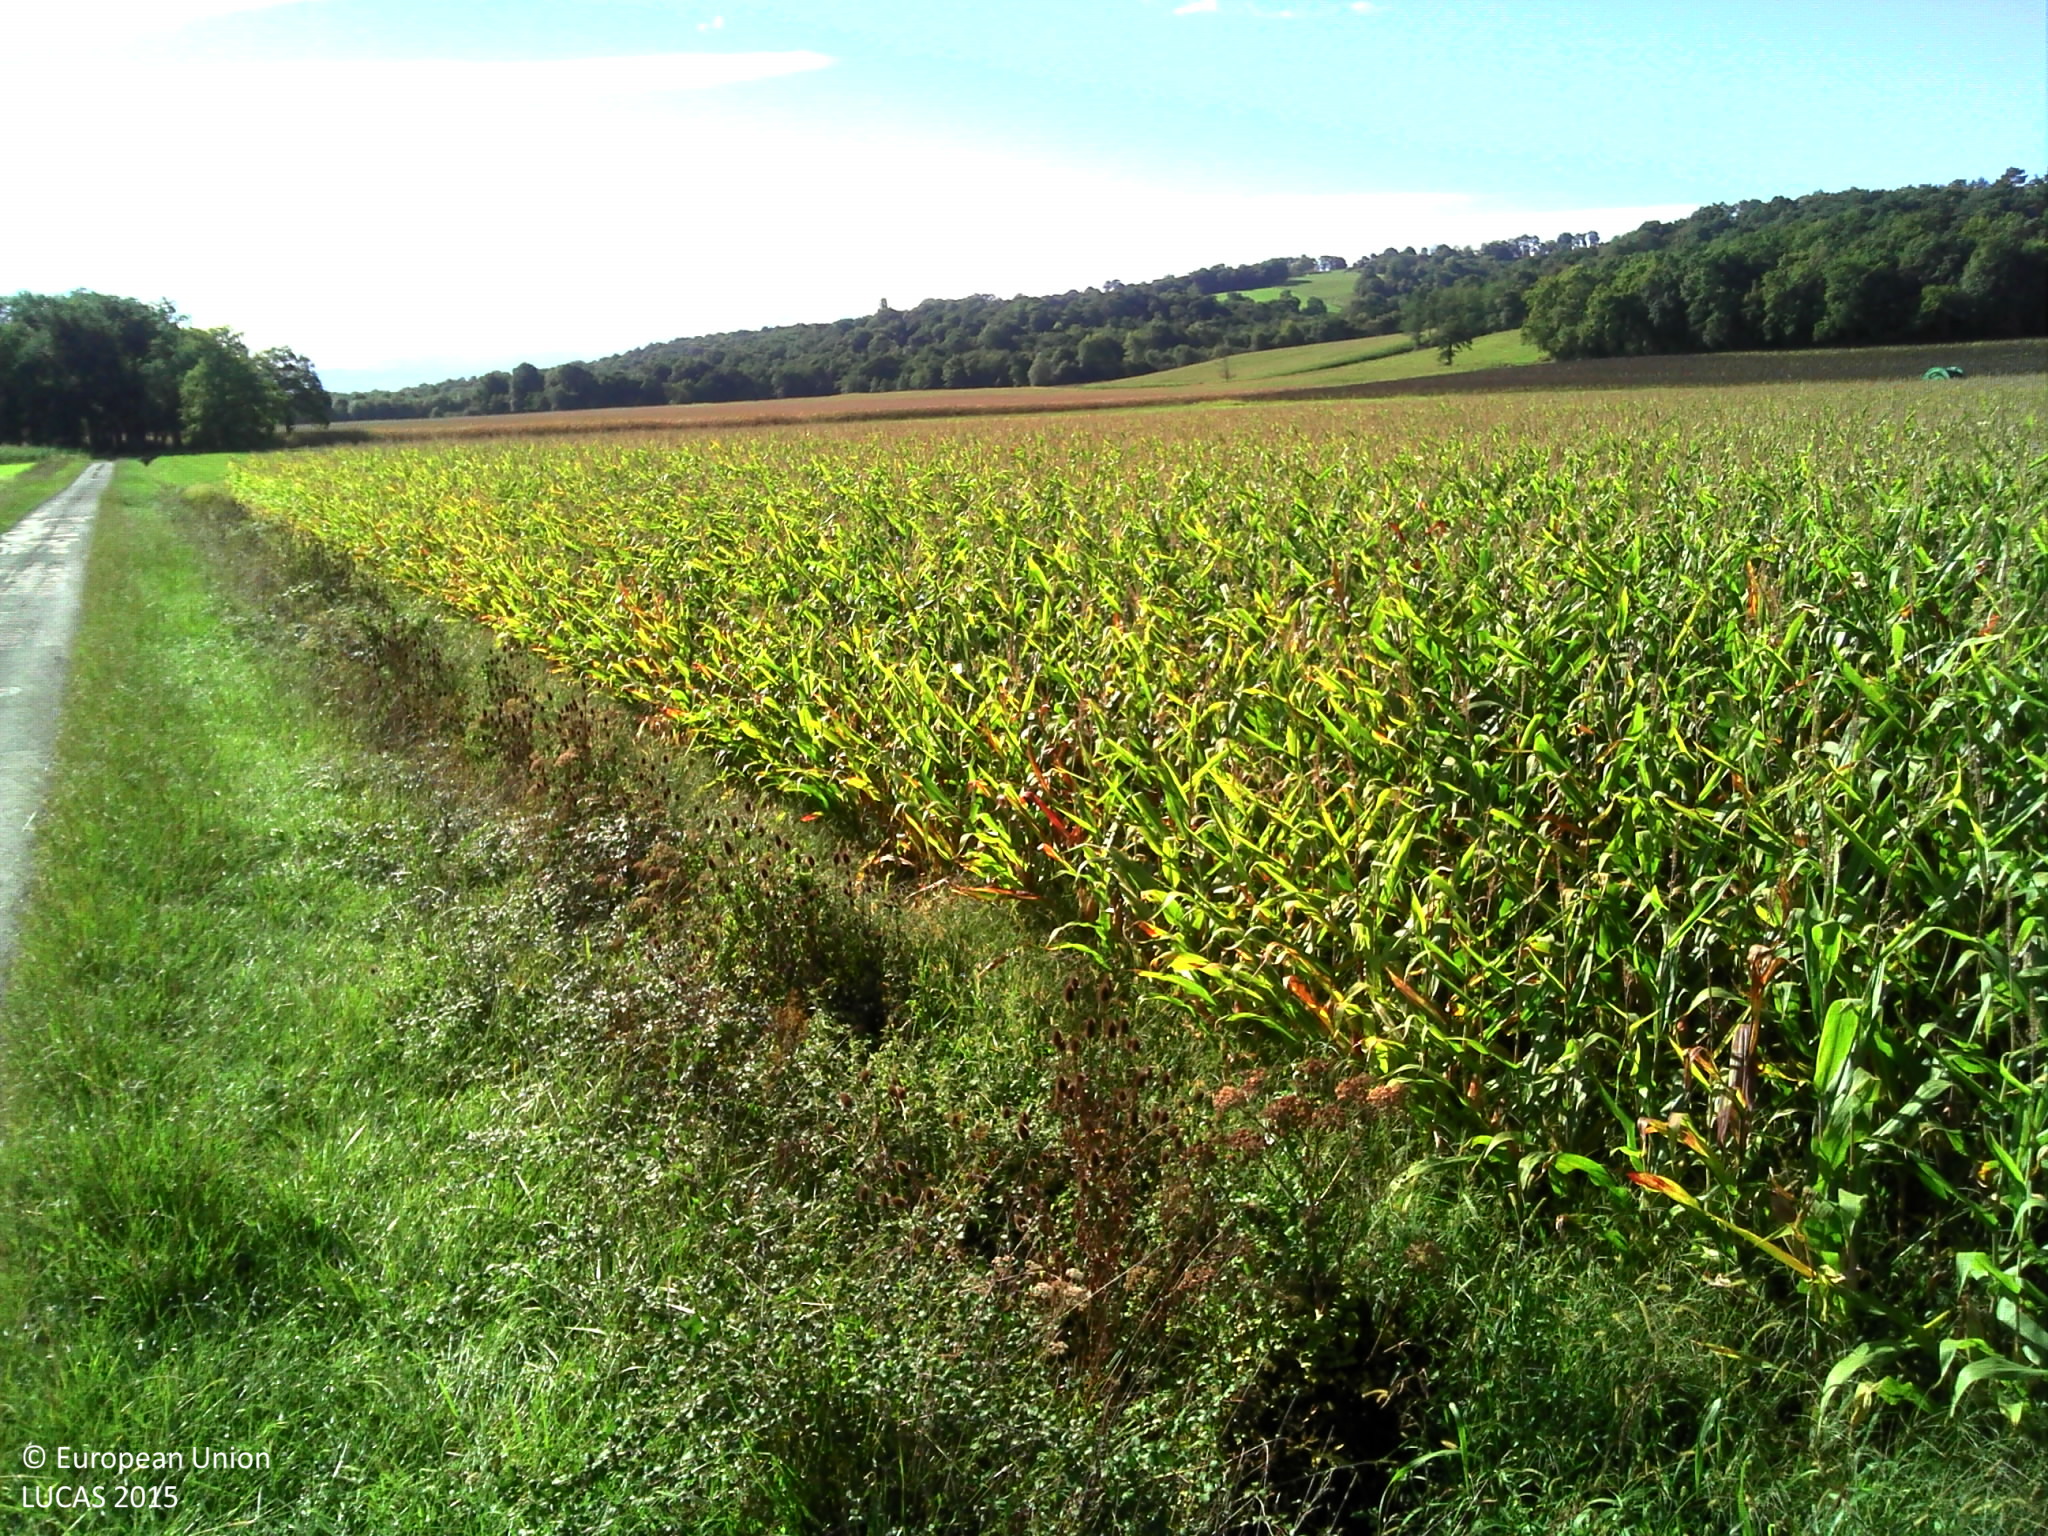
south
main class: Cropland
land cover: Maize
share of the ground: > 75 %
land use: Agriculture (excluding fallow land and kitchen gardens)
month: September
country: FR
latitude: 43.4477
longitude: -0.7241
